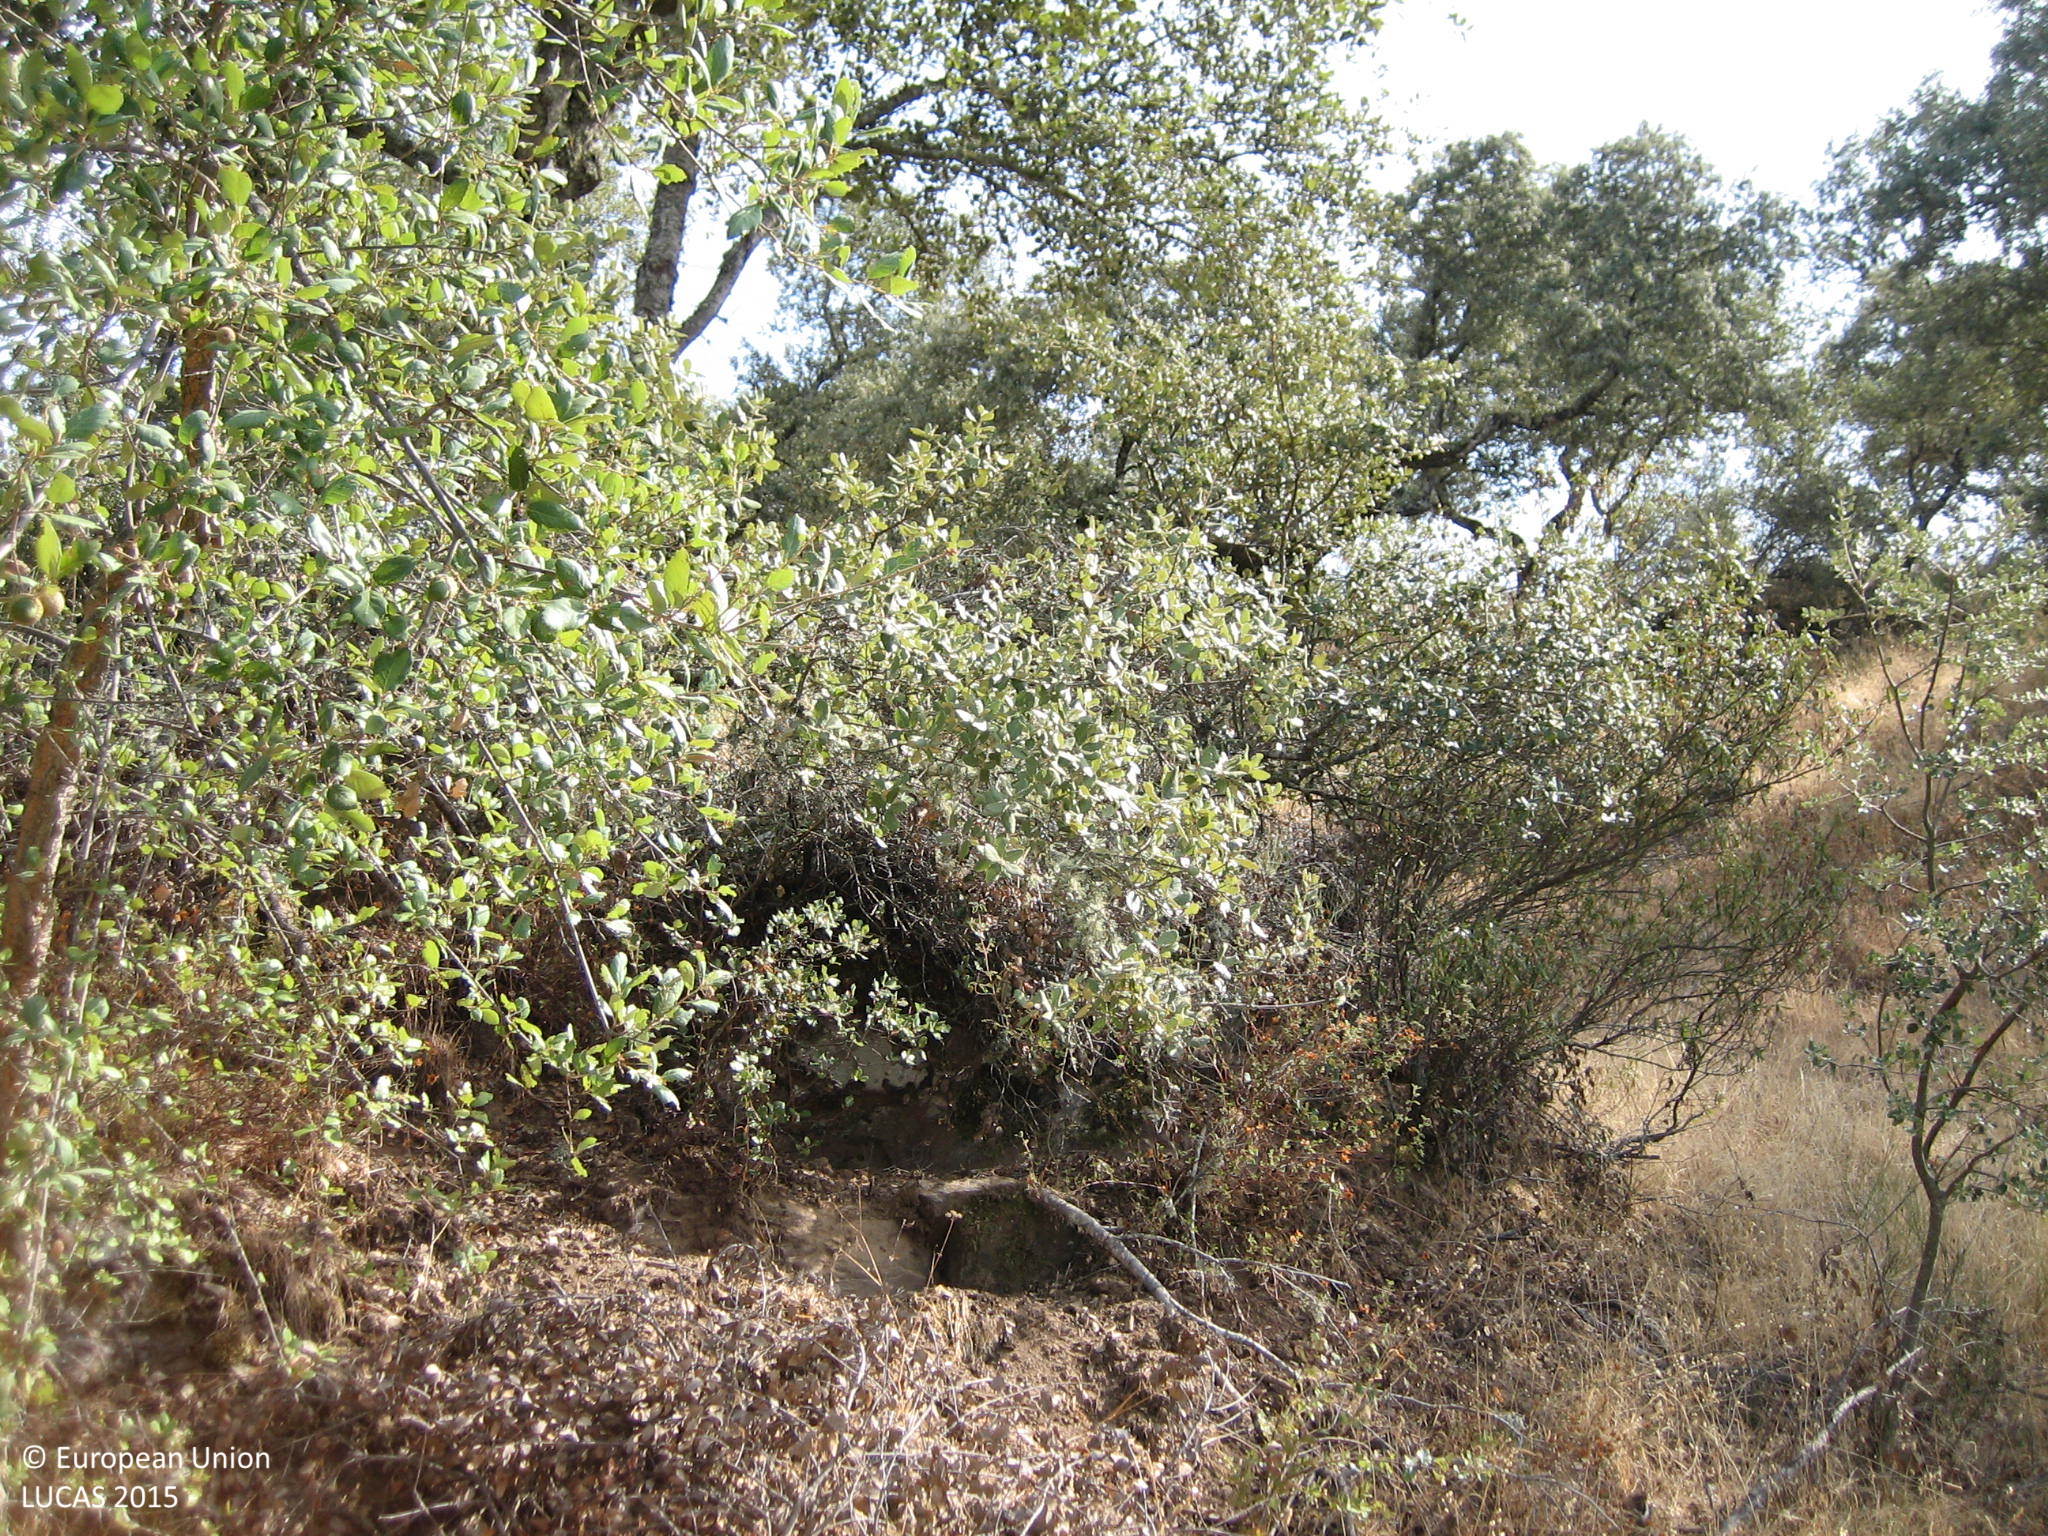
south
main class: Woodland
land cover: Broadleaved woodland
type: broadleaved evergreen forest
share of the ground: 50 - 75 %
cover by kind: broadleaved forest trees 50 %, shrubs 30 %, herbaceous plants 20 %
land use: Forestry
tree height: > 5 m
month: September
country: ES
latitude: 38.2014
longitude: -6.7827
